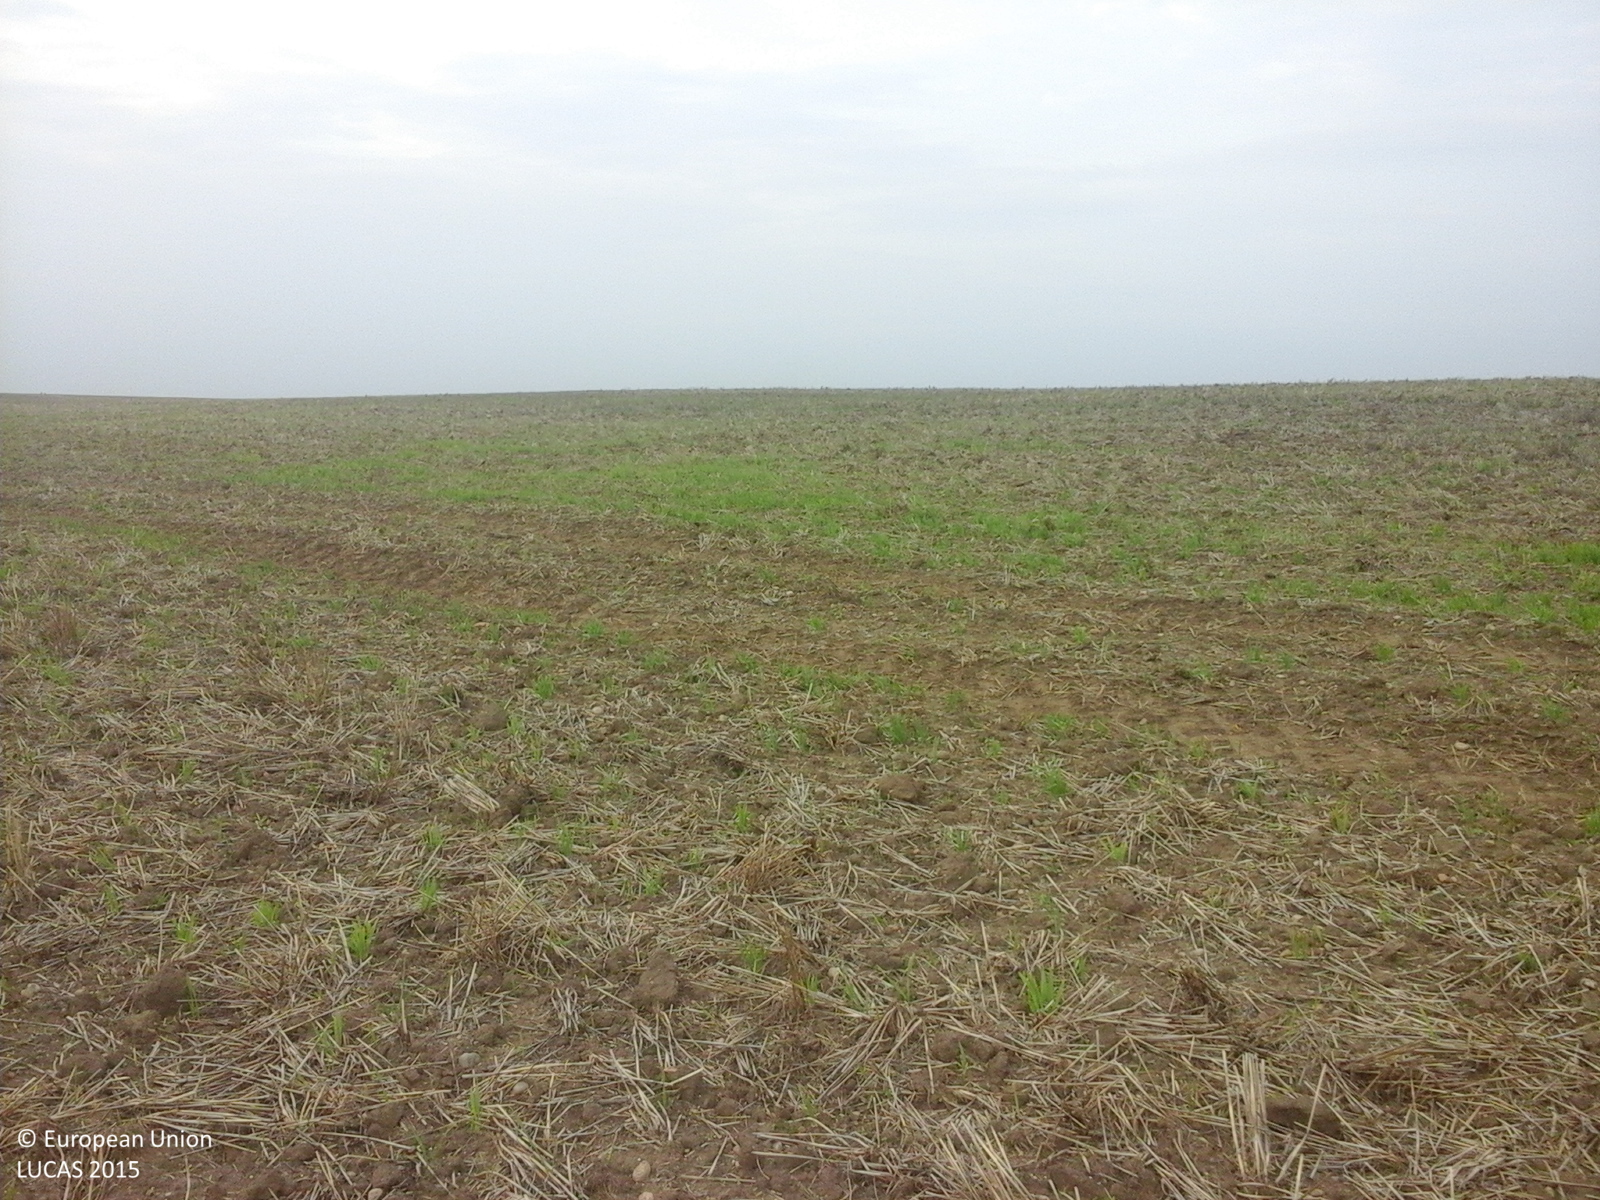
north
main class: Cropland
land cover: Common wheat
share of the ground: < 10 %
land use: Agriculture (excluding fallow land and kitchen gardens)
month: August
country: RO
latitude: 46.2215
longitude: 21.4836
